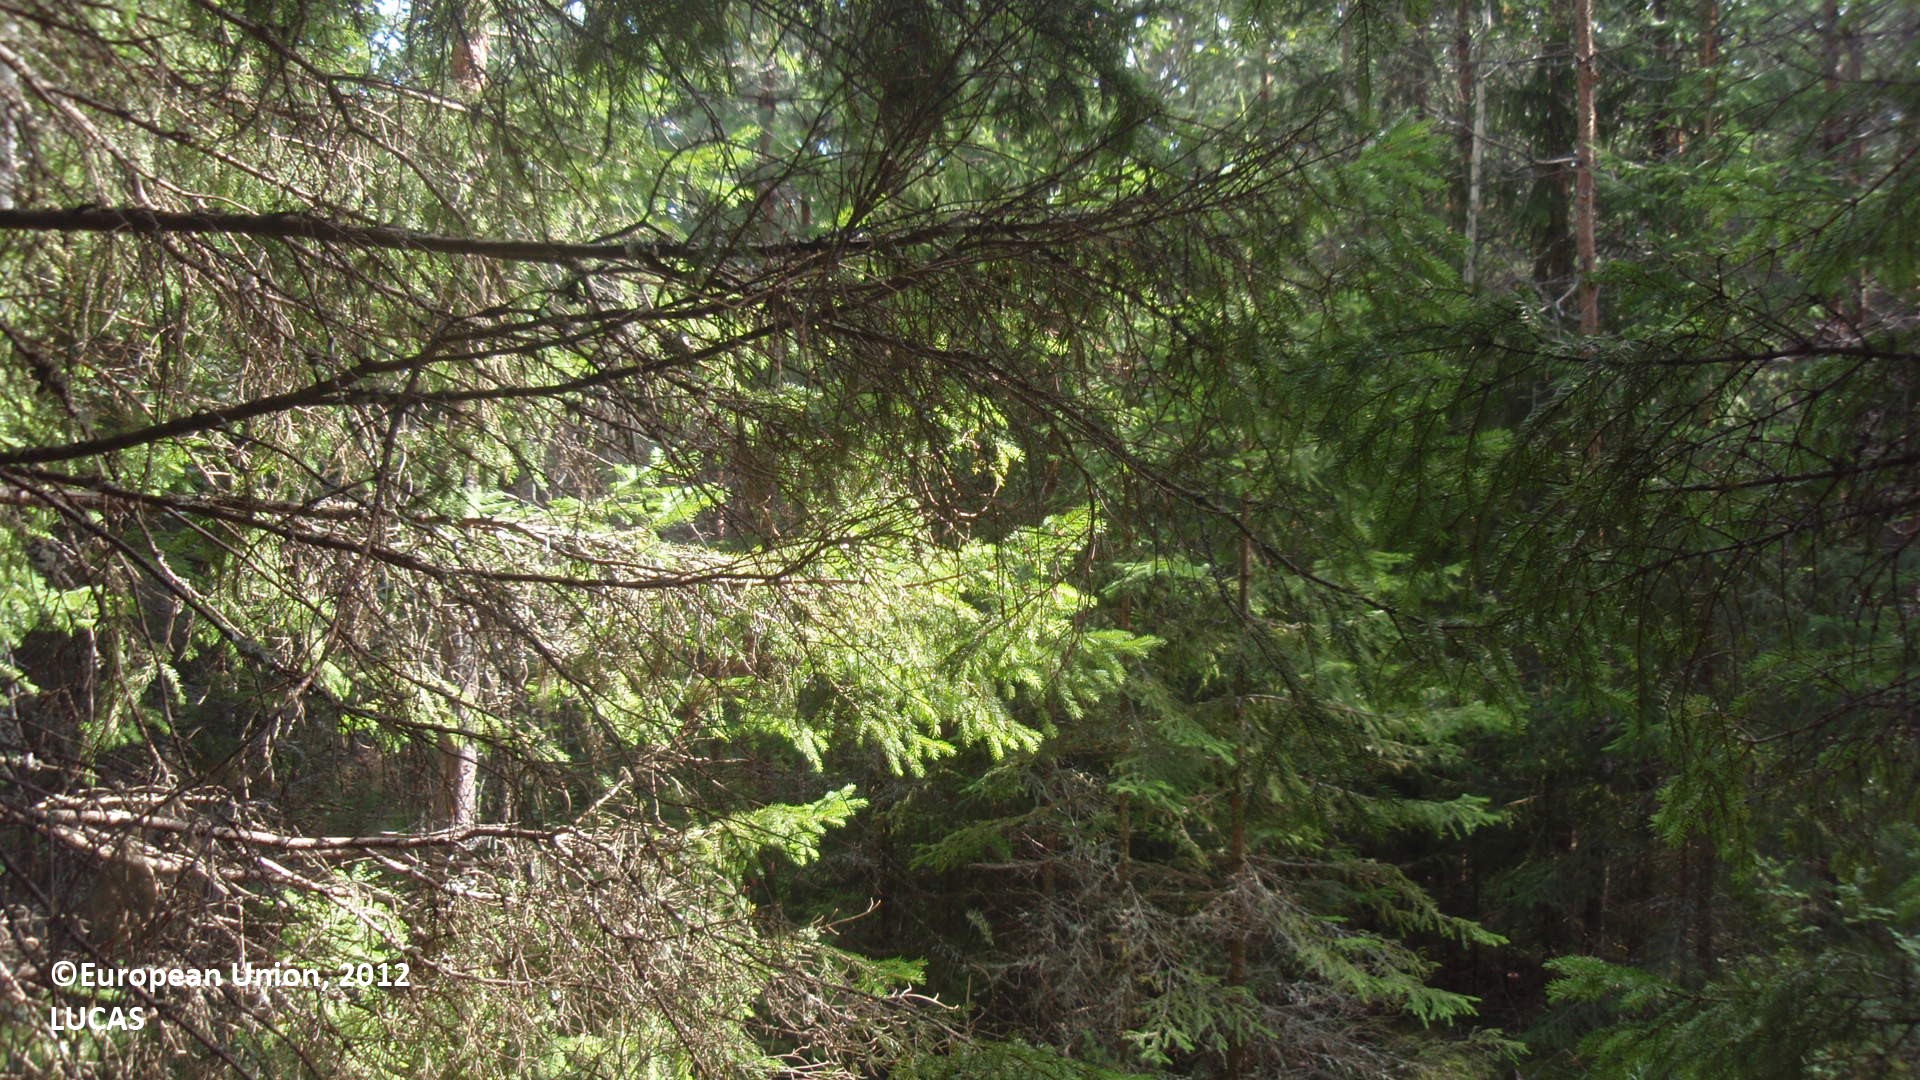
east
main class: Woodland
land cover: Spruce dominated coniferous woodland
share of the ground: 50 - 75 %
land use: Forestry
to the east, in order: Spruce dominated coniferous woodland; Tracks; Spruce dominated mixed woodland; Paved roads, cycling and walking lanes; Spruce dominated coniferous woodland; Artificial constructions in urban areas
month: August
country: FI
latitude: 61.2027
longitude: 27.0449
